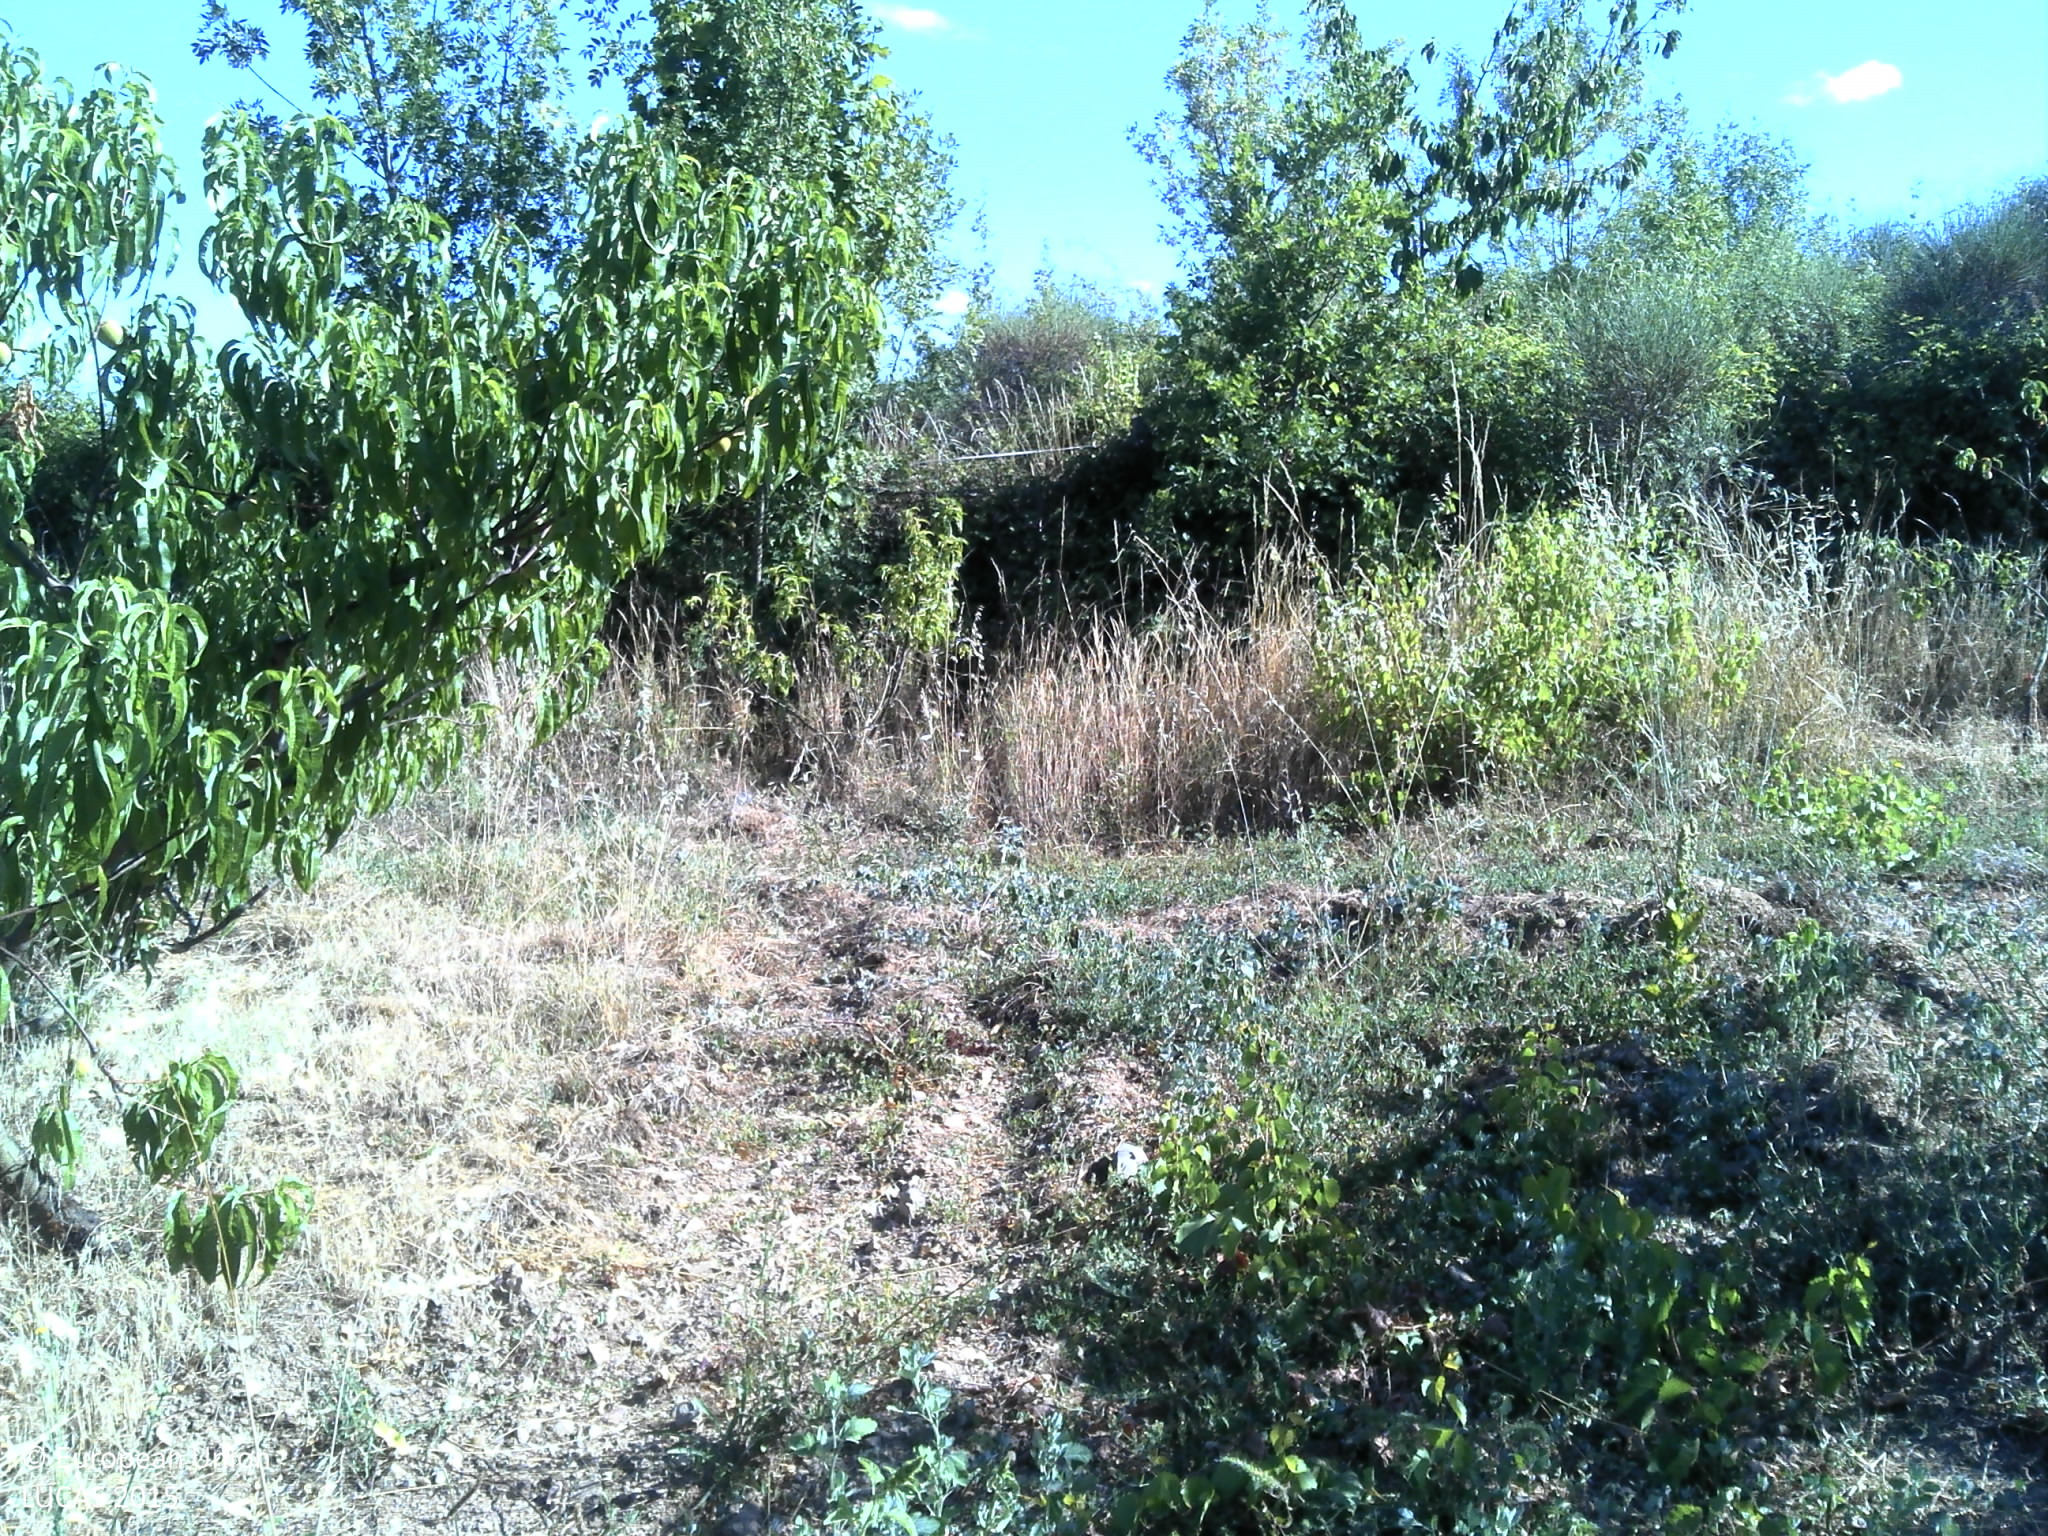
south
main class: Cropland
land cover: Other fruit trees and berries
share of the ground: 10 - 25 %
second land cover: Spontaneously vegetated surfaces
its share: > 75 %
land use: Agriculture (excluding fallow land and kitchen gardens)
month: July
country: FR
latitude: 43.6519
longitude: 3.1267
